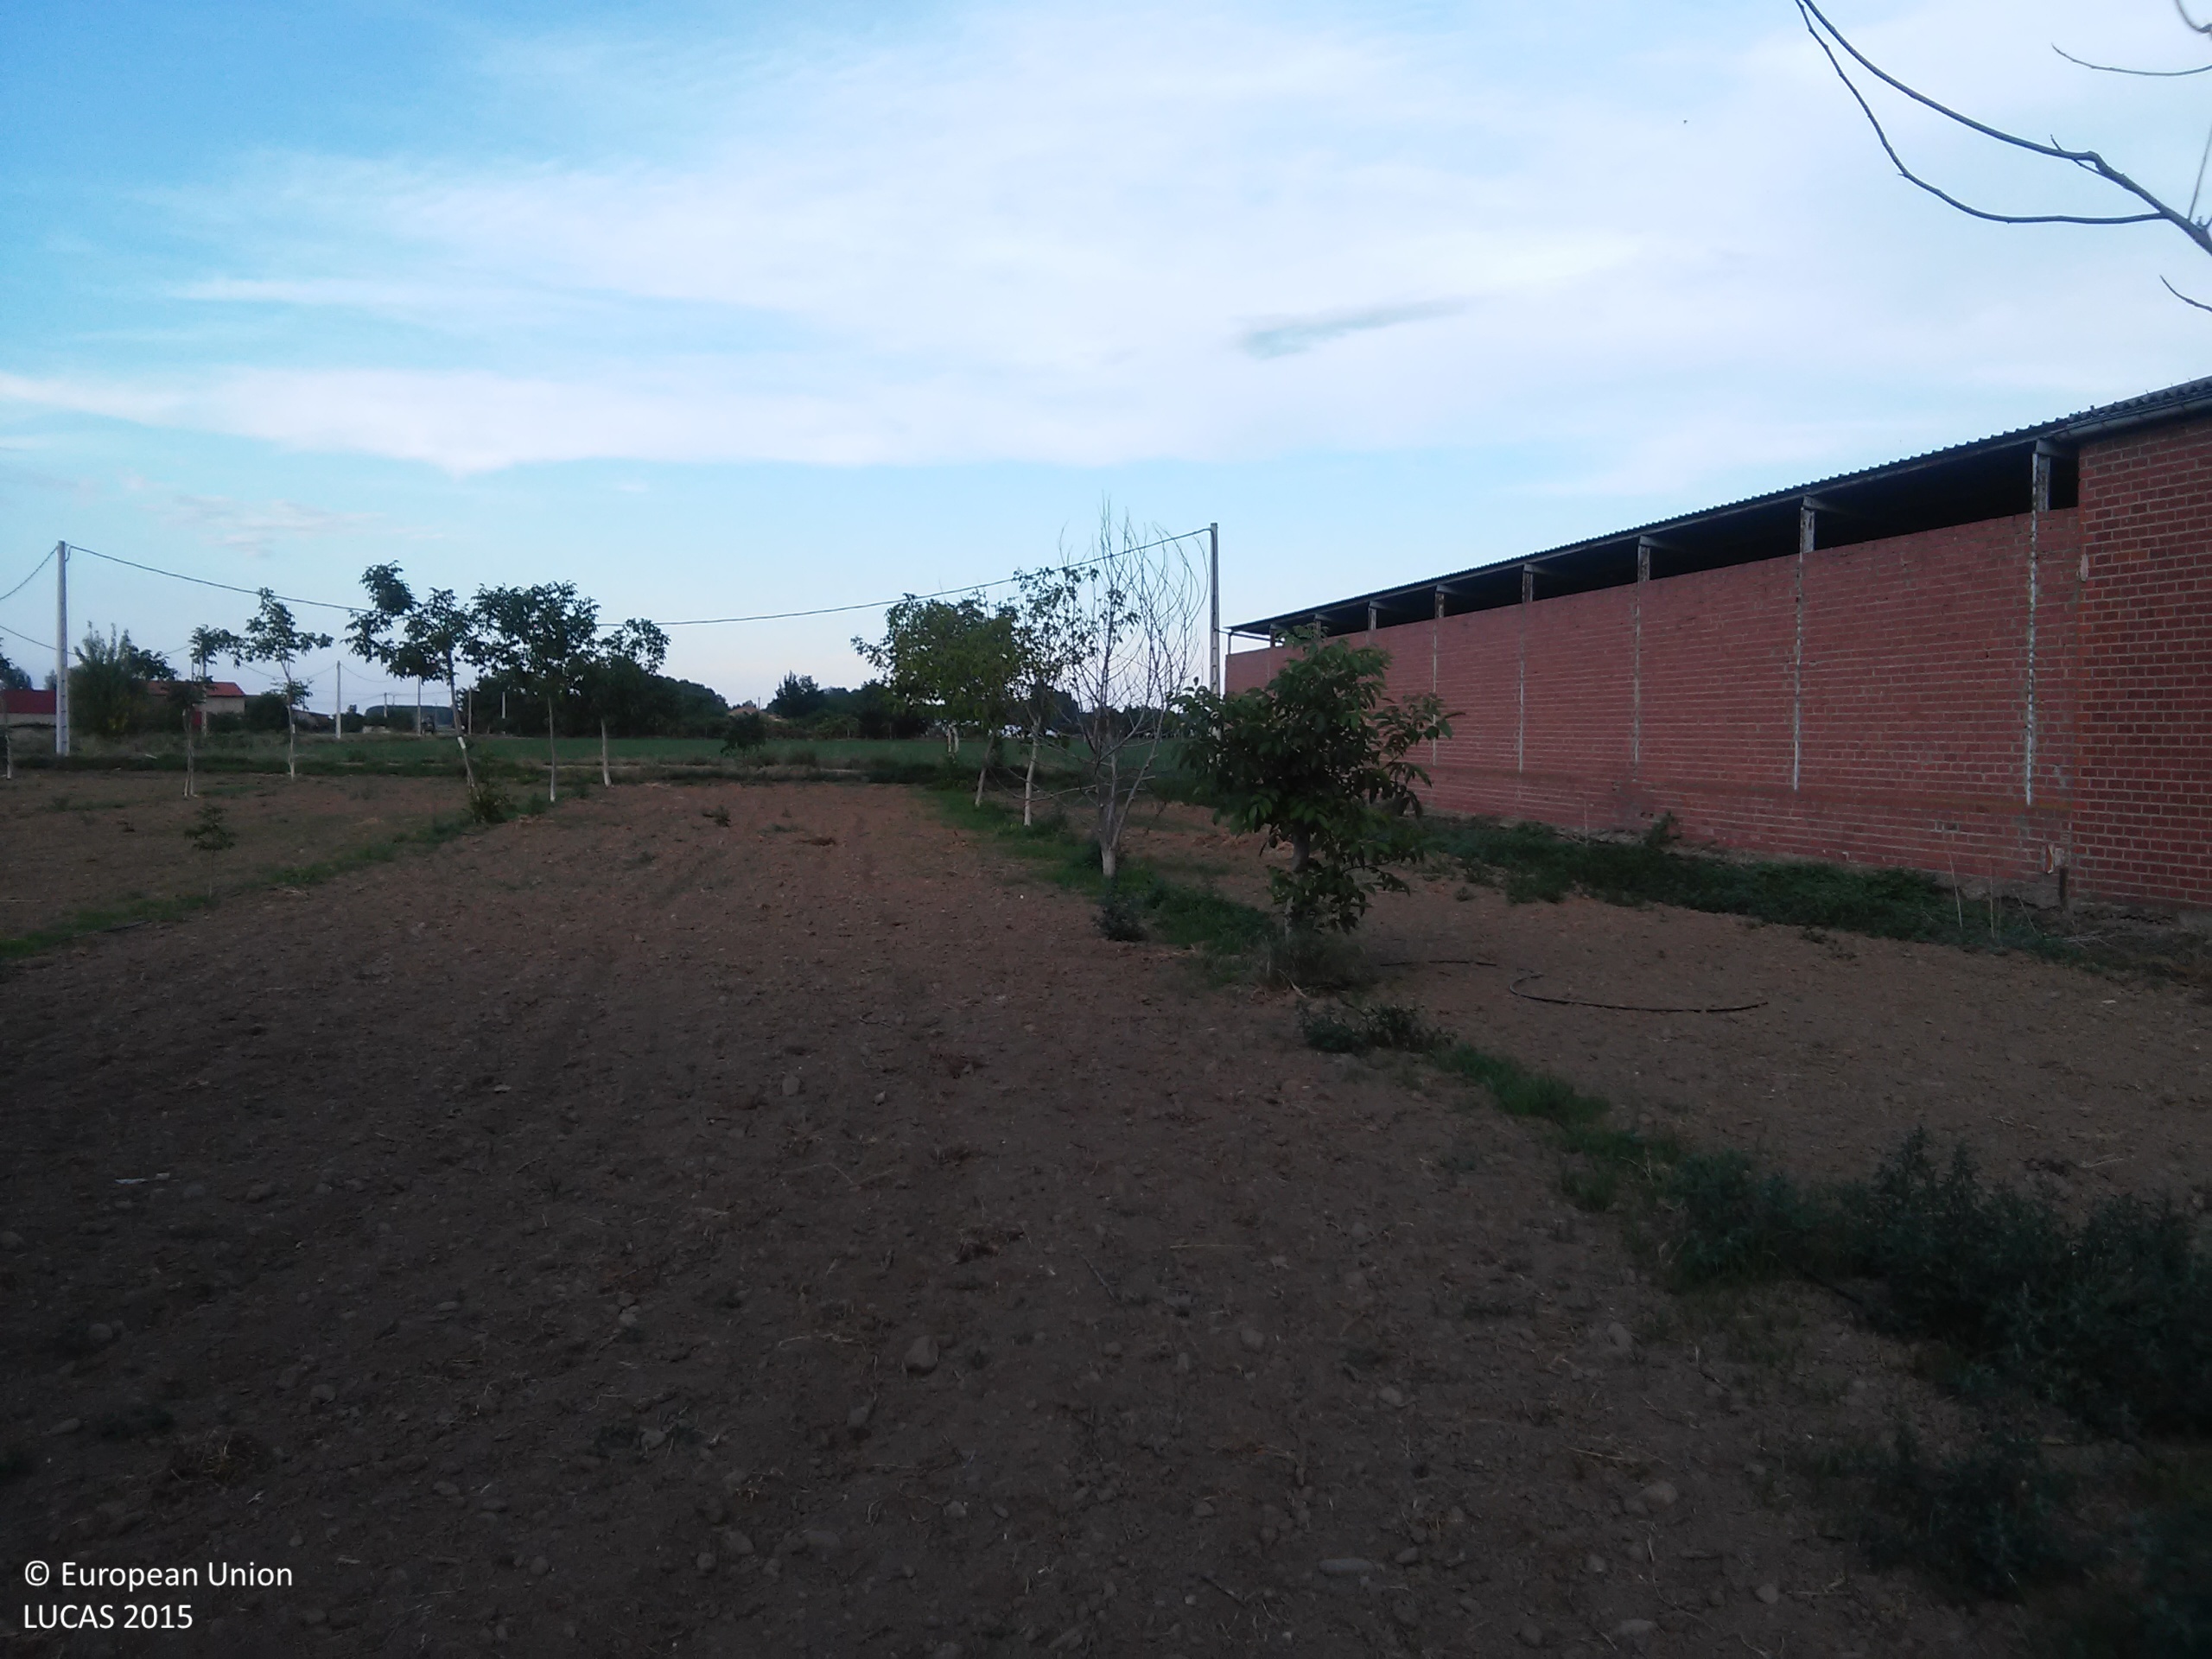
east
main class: Cropland
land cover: Nuts trees
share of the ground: < 10 %
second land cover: Other bare soil
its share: > 75 %
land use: Agriculture (excluding fallow land and kitchen gardens)
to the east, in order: Nuts trees; Other bare soil; Ditches and canals; Electric lines; Grass margins; Tracks; Grass margins; Maize; Grass margins; Tracks
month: June
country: ES
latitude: 42.4365
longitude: -5.5452
